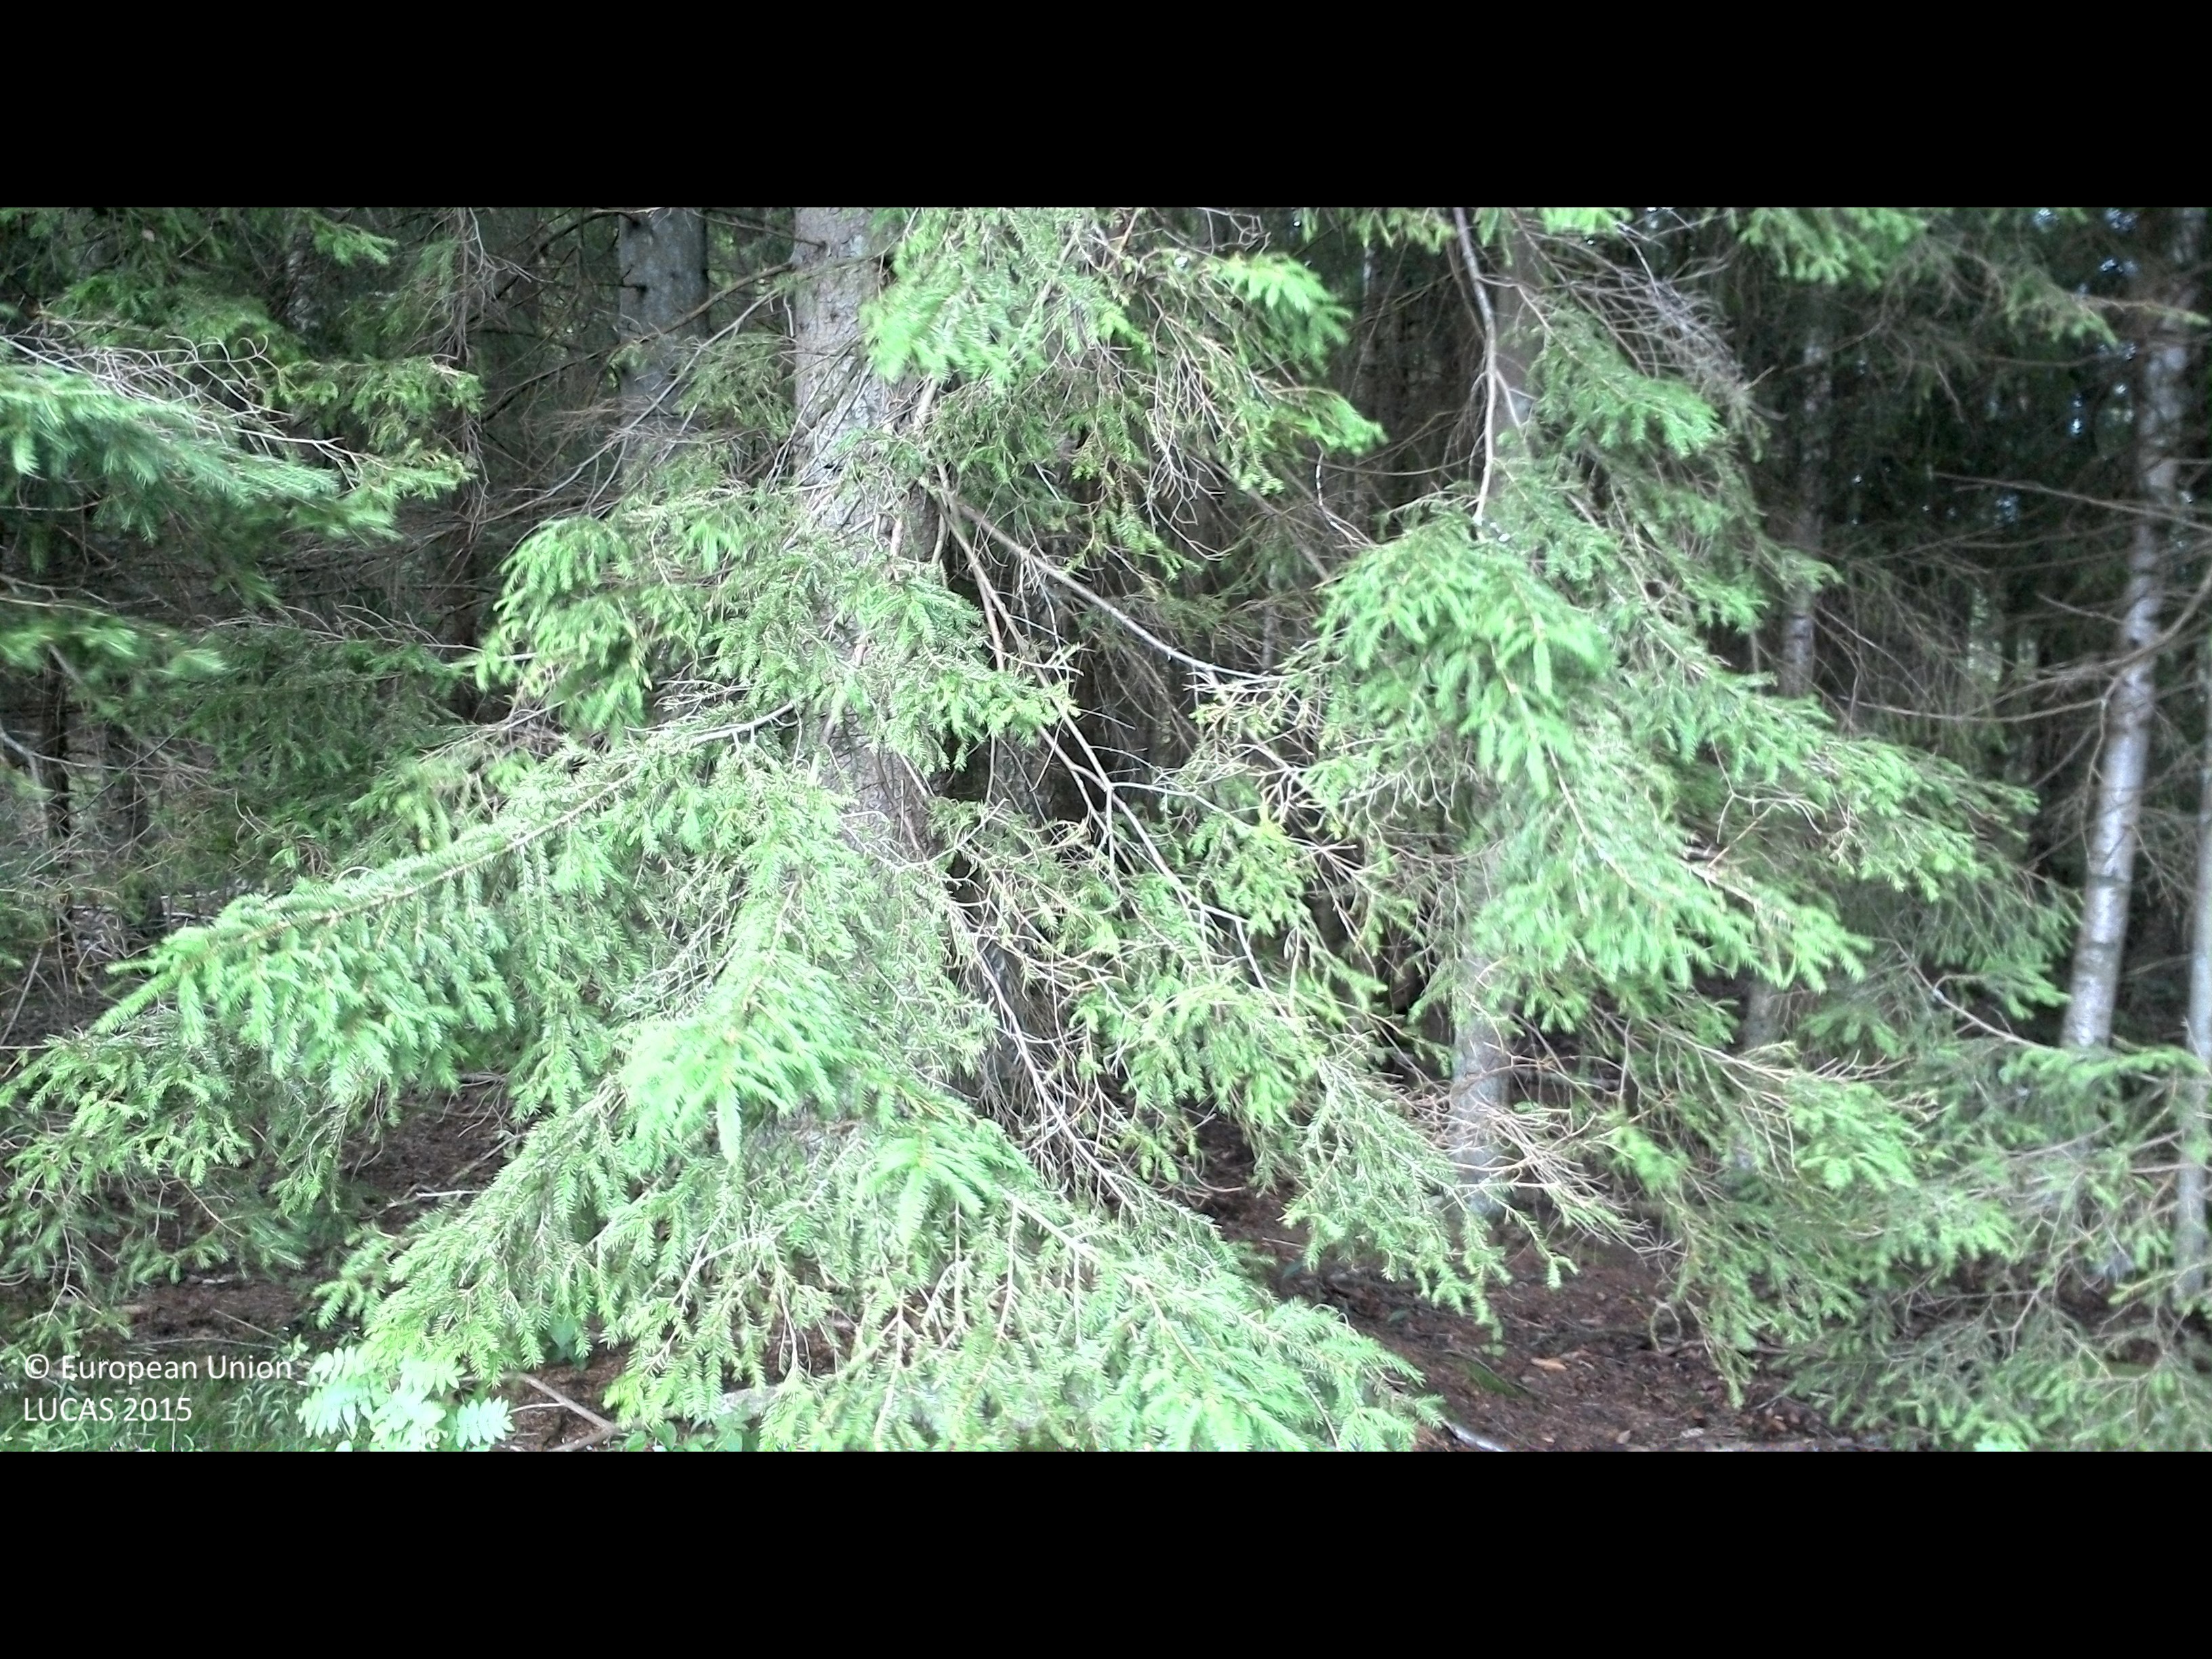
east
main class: Woodland
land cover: Spruce dominated mixed woodland
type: boreal forest
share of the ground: > 75 %
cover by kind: coniferous forest trees 55 %, broadleaved forest trees 20 %, shrubs 15 %, herbaceous plants 10 %
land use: Forestry
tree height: > 5 m
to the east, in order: Spruce dominated mixed woodland; Spruce dominated coniferous woodland; Broadleaved woodland; Spruce dominated coniferous woodland
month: July
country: SE
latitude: 56.4600
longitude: 14.7527
